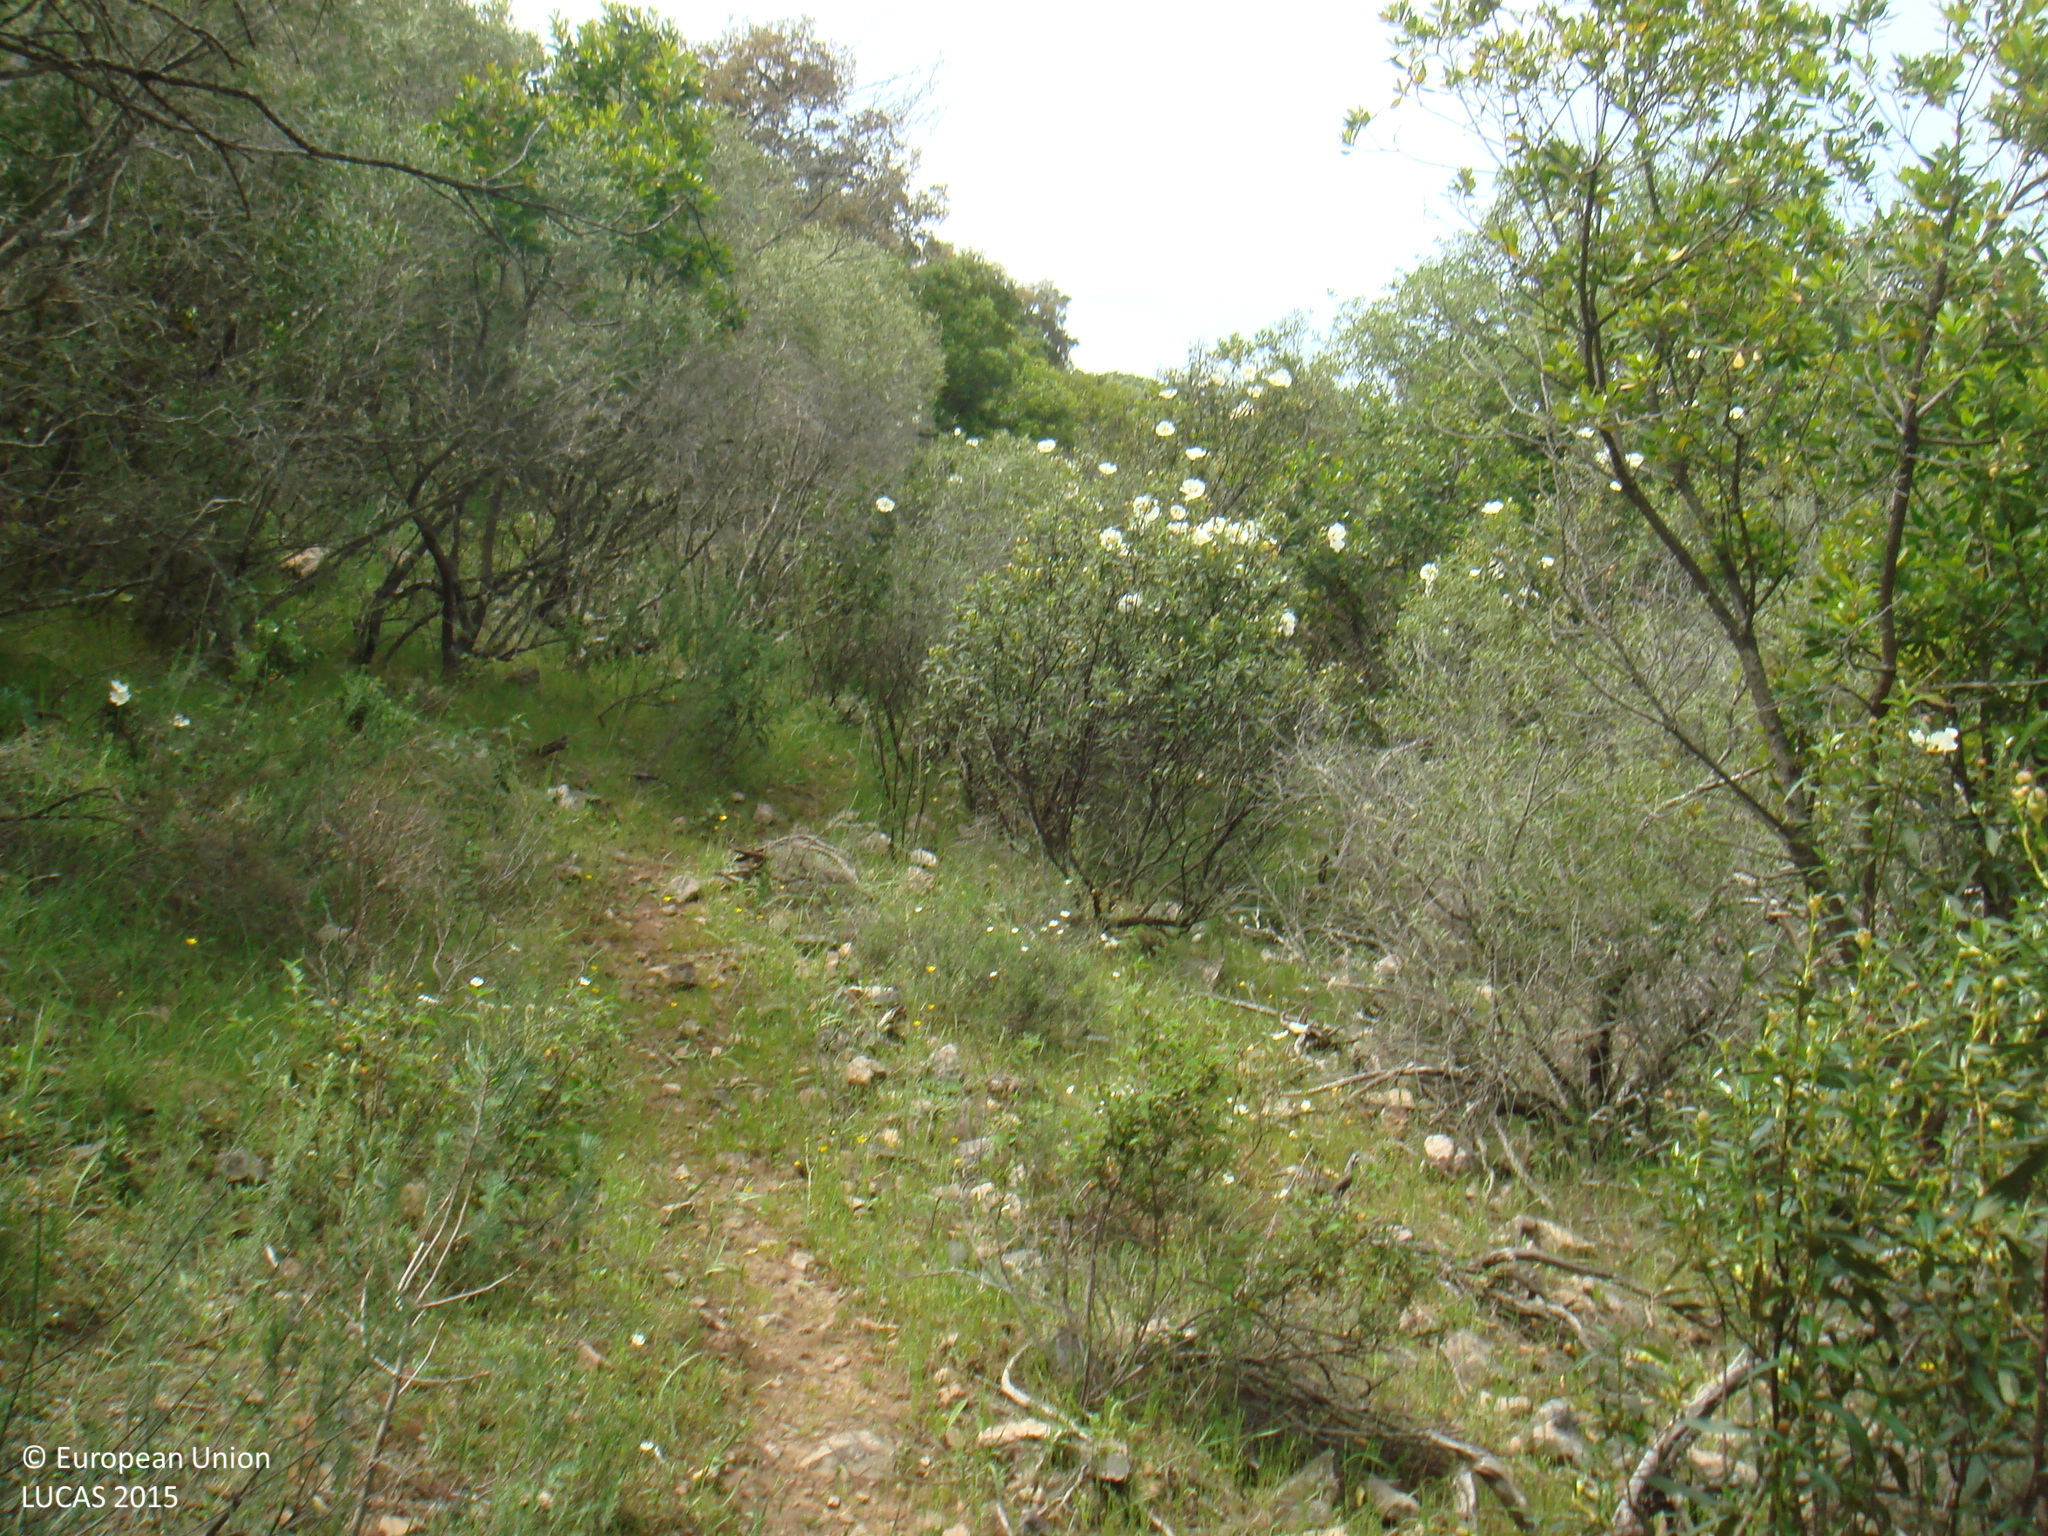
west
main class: Woodland
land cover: Broadleaved woodland
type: broadleaved evergreen forest
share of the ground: 25 - 50 %
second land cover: Shrubland without tree cover
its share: 50 - 75 %
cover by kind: shrubs 50 %, broadleaved forest trees 40 %, herbaceous plants 10 %
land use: Forestry
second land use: Agriculture (excluding fallow land and kitchen gardens)
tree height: > 5 m
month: May
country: ES
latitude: 38.3207
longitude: -5.0899
